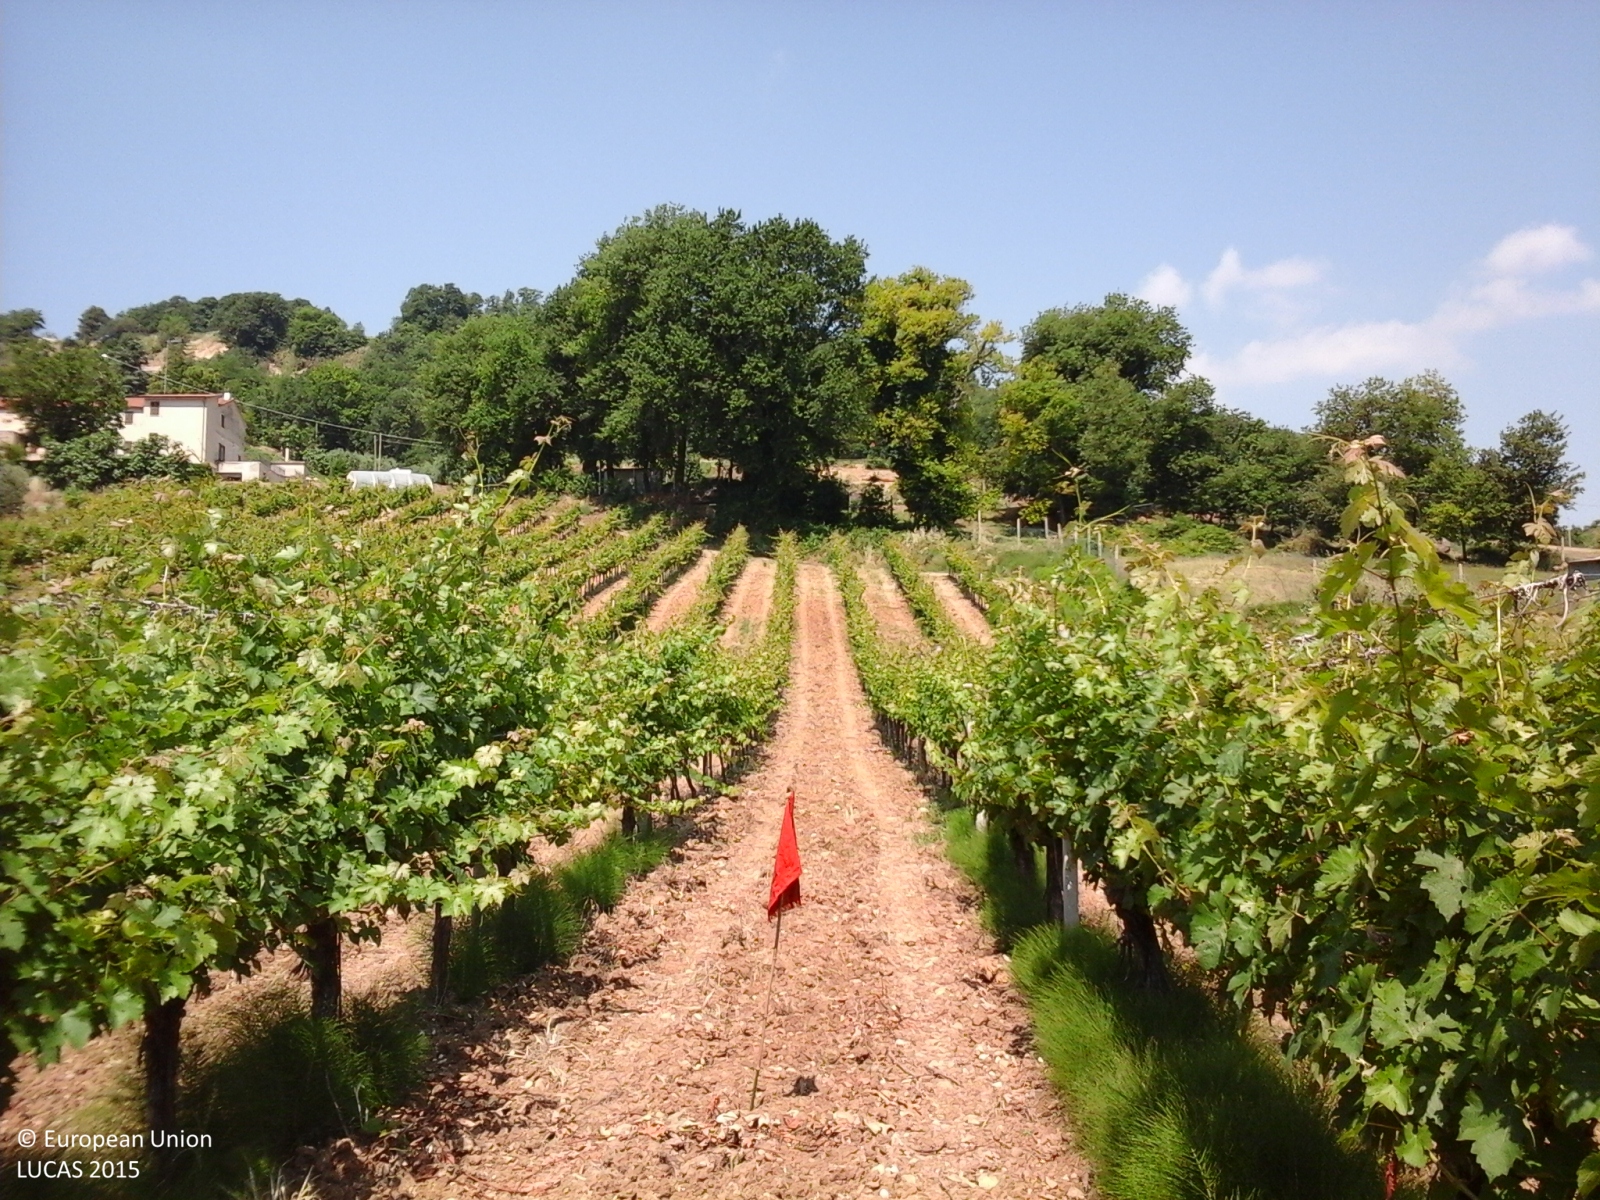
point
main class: Cropland
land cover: Vineyards
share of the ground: 50 - 75 %
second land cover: Other bare soil
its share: > 75 %
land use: Agriculture (excluding fallow land and kitchen gardens)
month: June
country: IT
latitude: 42.9992
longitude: 13.7802
